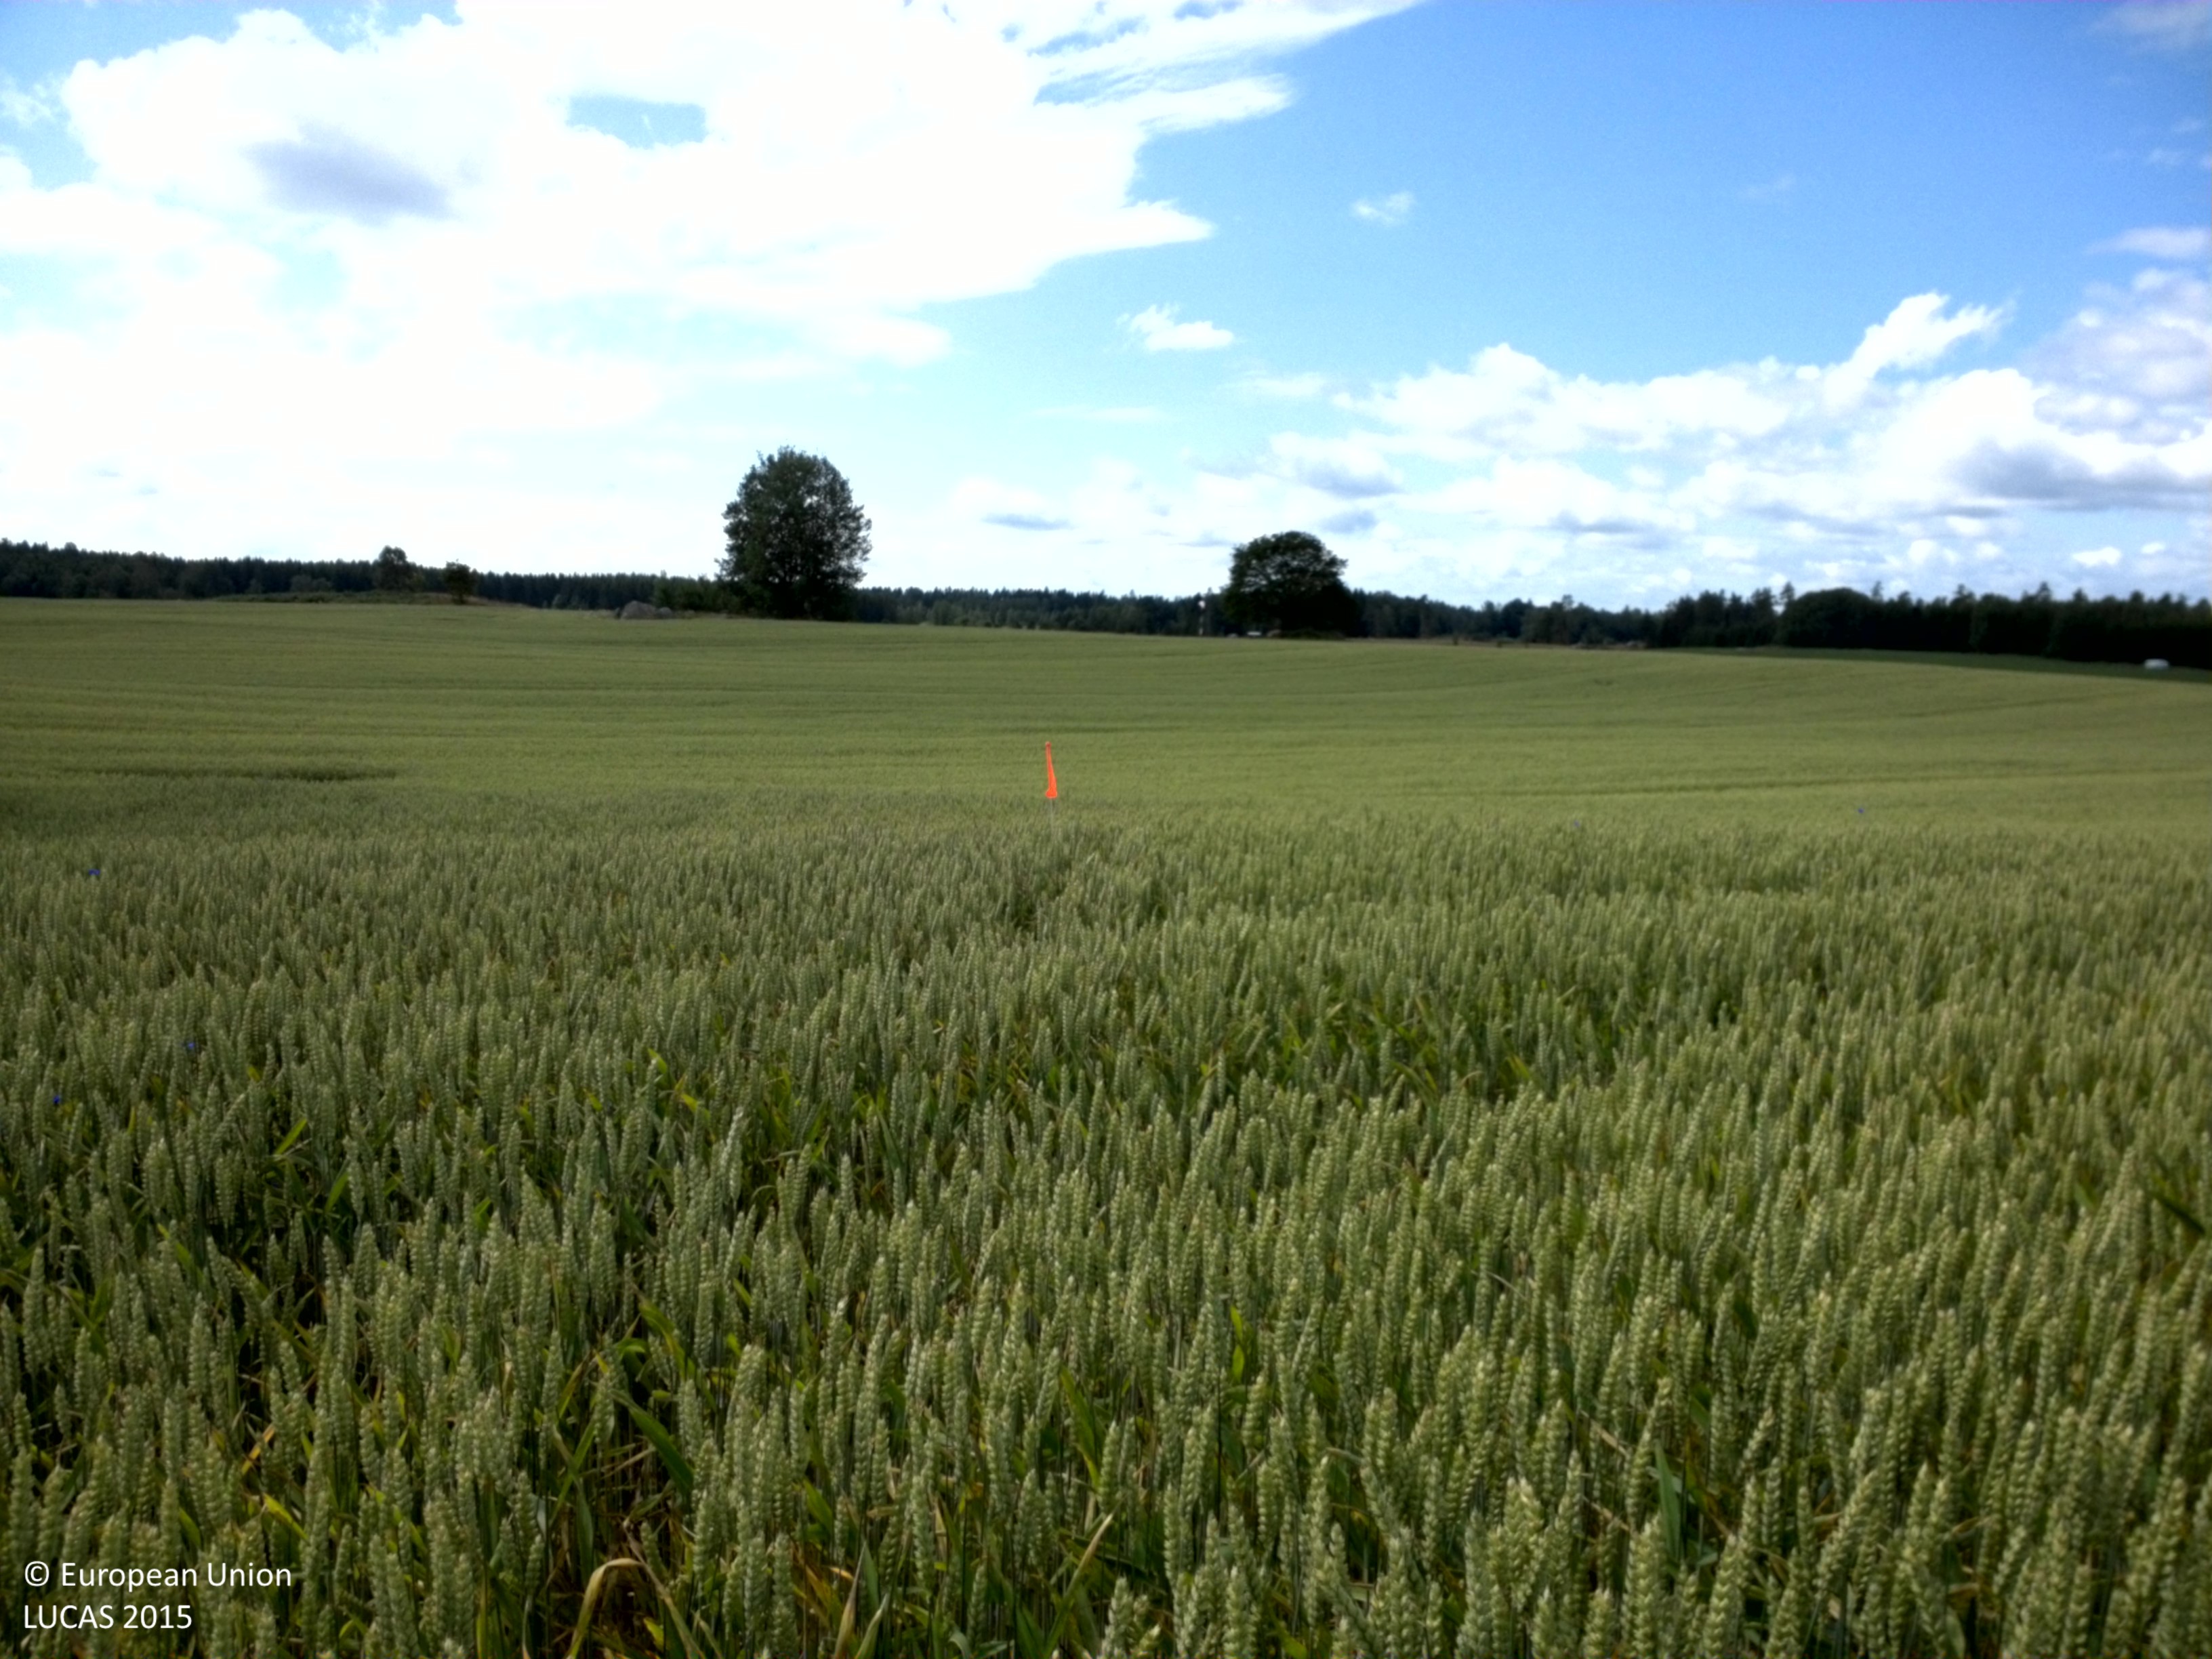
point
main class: Cropland
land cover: Common wheat
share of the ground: > 75 %
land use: Agriculture (excluding fallow land and kitchen gardens)
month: July
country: SE
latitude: 58.7339
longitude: 15.6077
